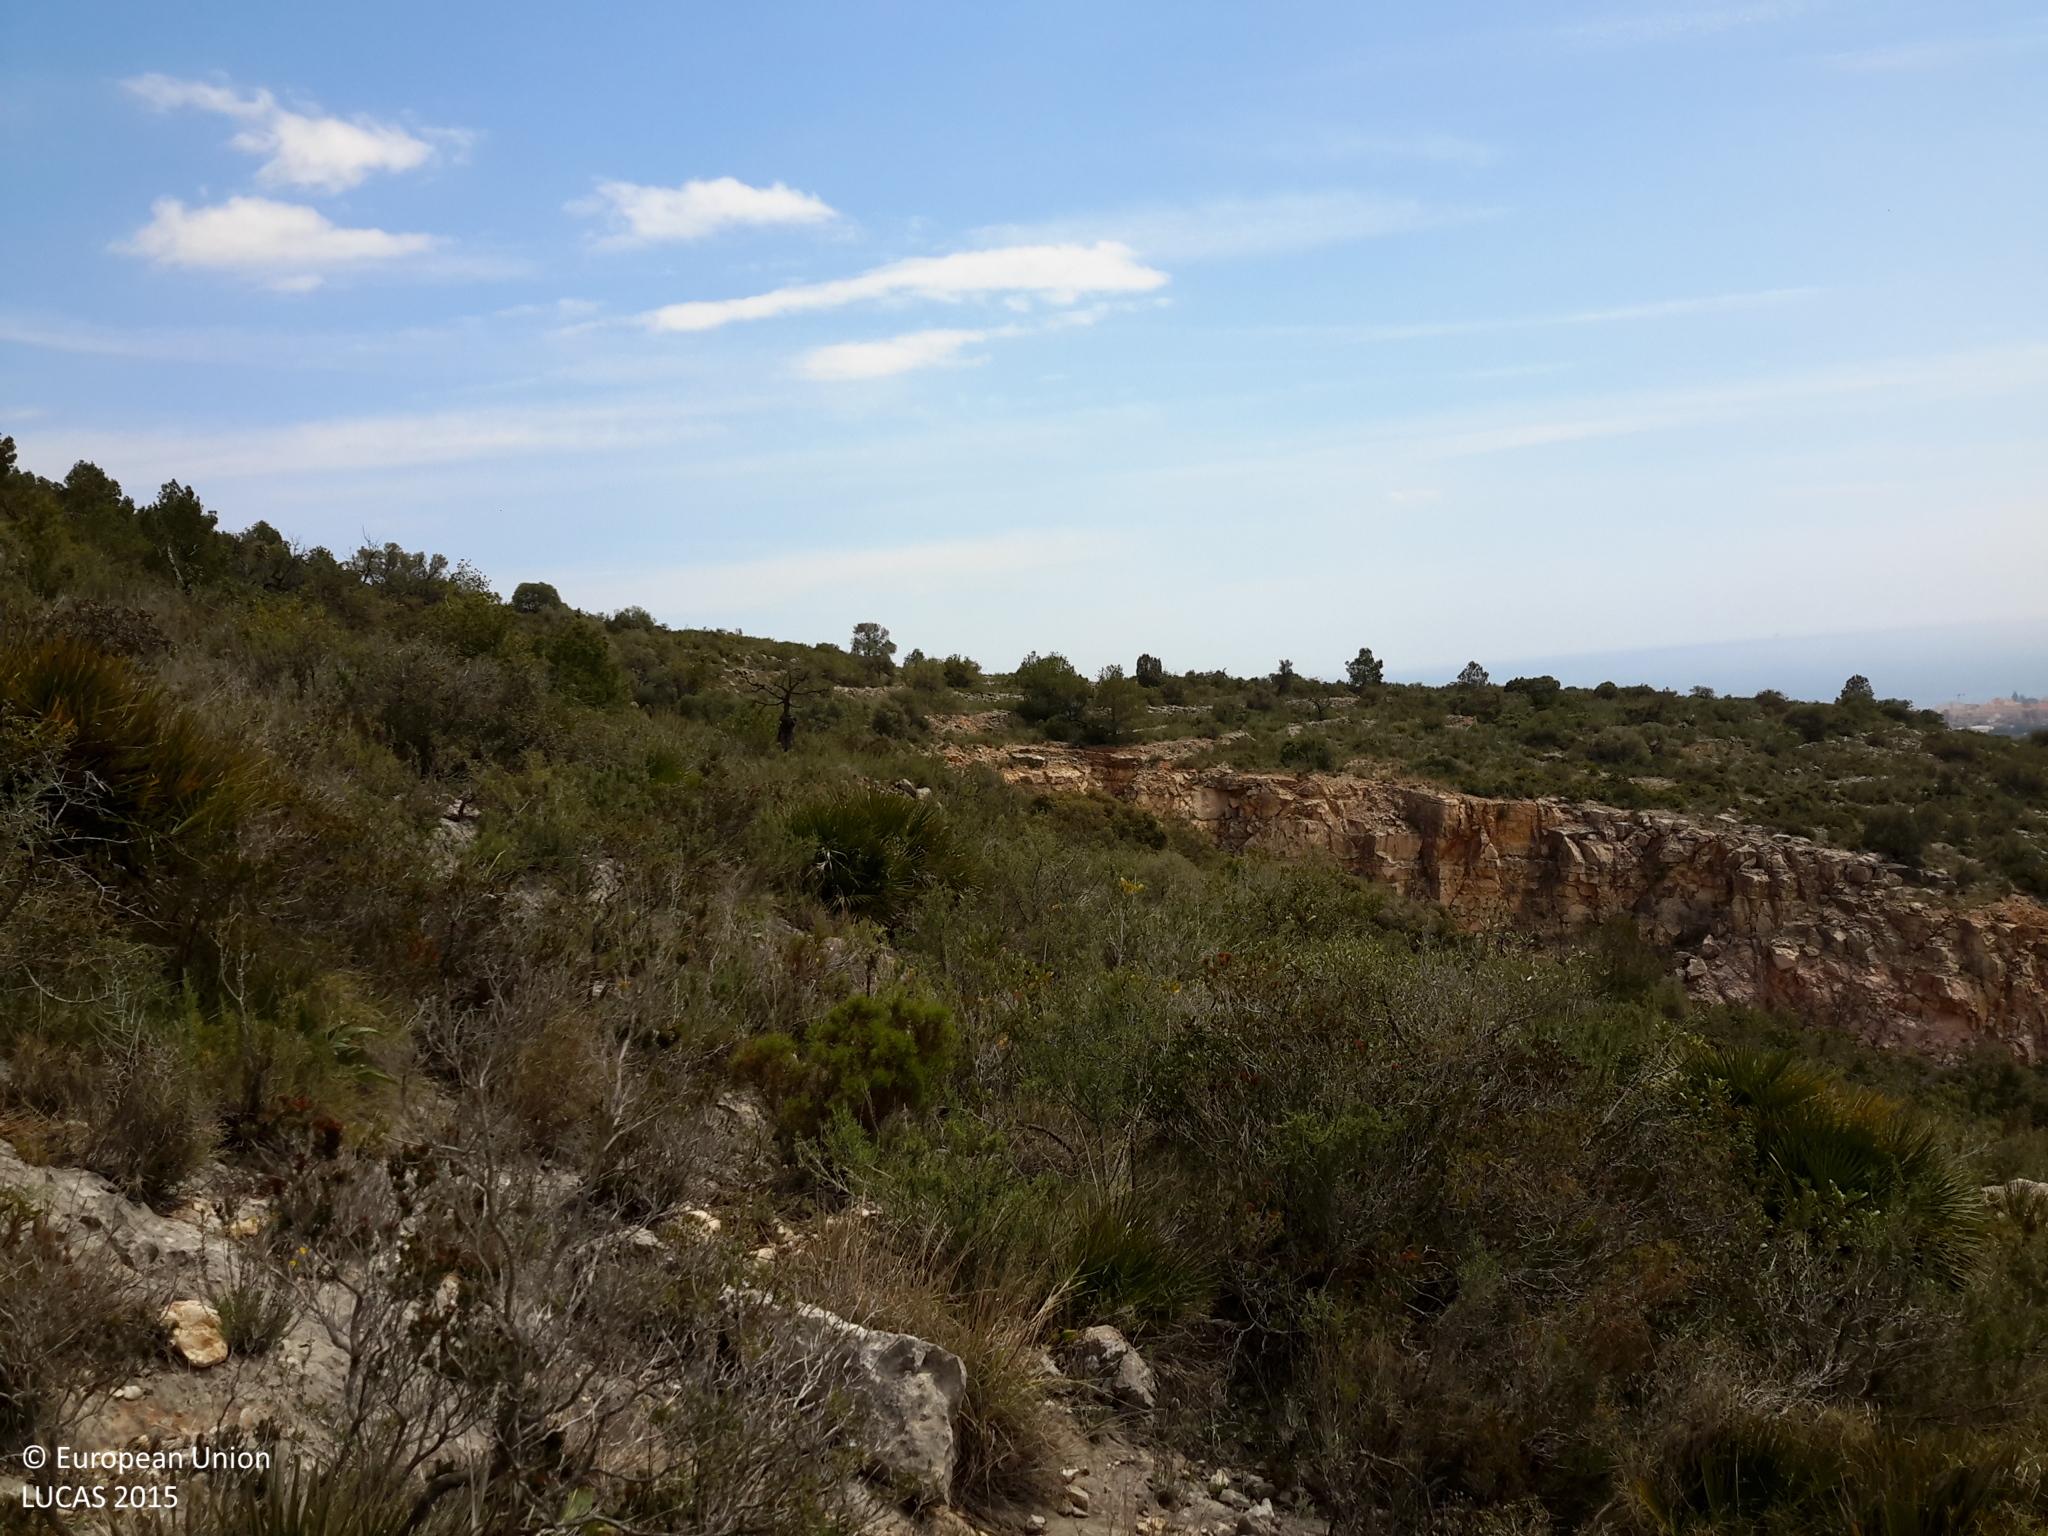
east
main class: Shrubland
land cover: Shrubland with sparse tree cover
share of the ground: > 75 %
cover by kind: shrubs 70 %, unconsolidated bare surface 25 %, coniferous forest trees 5 %
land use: Semi-natural and natural areas not in use
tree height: < 5 m
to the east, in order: Shrubland with sparse tree cover; Dry stone walls; Shrubland with sparse tree cover; Dry stone walls; Pine dominated coniferous woodland; Shrubland with sparse tree cover; Dry stone walls; Shrubland with sparse tree cover; Dry stone walls; Permanent industrial crops; Dry stone walls; Olive groves; Tracks; Olive groves
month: April
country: ES
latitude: 40.5709
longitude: 0.5107
